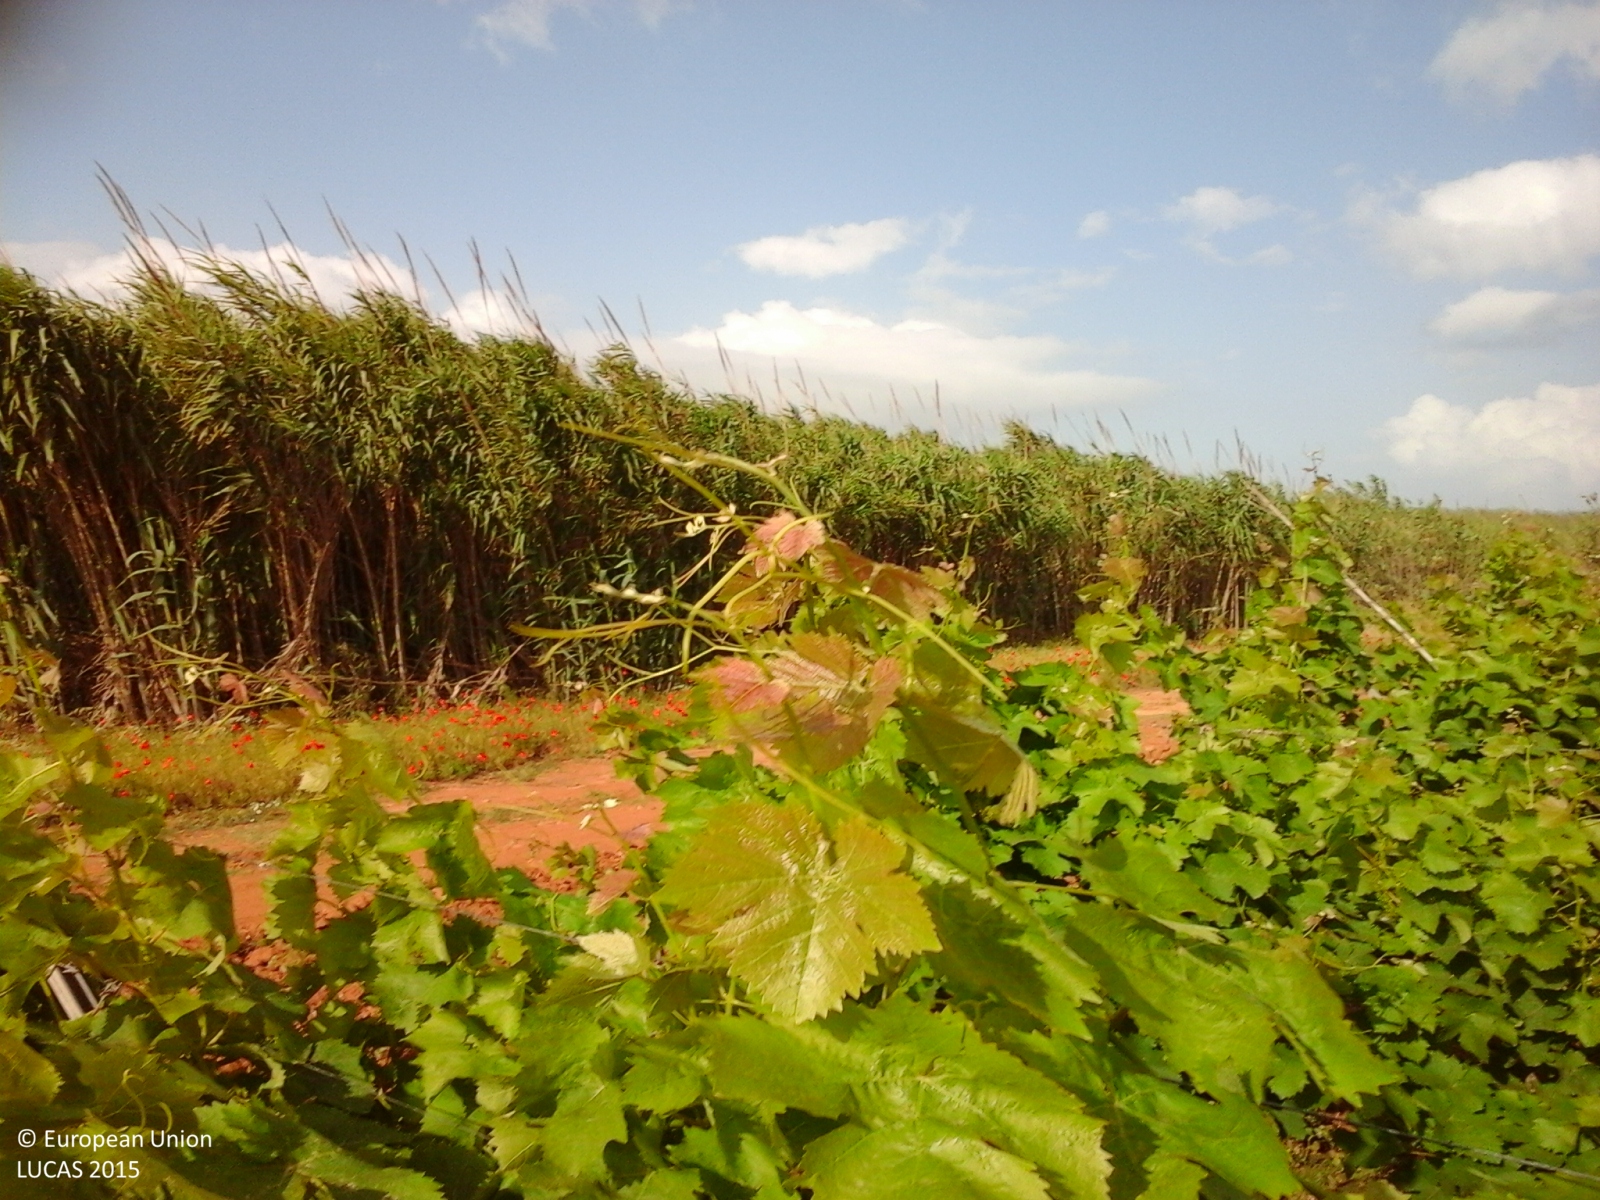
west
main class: Cropland
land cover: Vineyards
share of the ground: 25 - 50 %
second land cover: Spontaneously vegetated surfaces
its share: 50 - 75 %
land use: Agriculture (excluding fallow land and kitchen gardens)
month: May
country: IT
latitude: 37.5643
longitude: 12.6851
